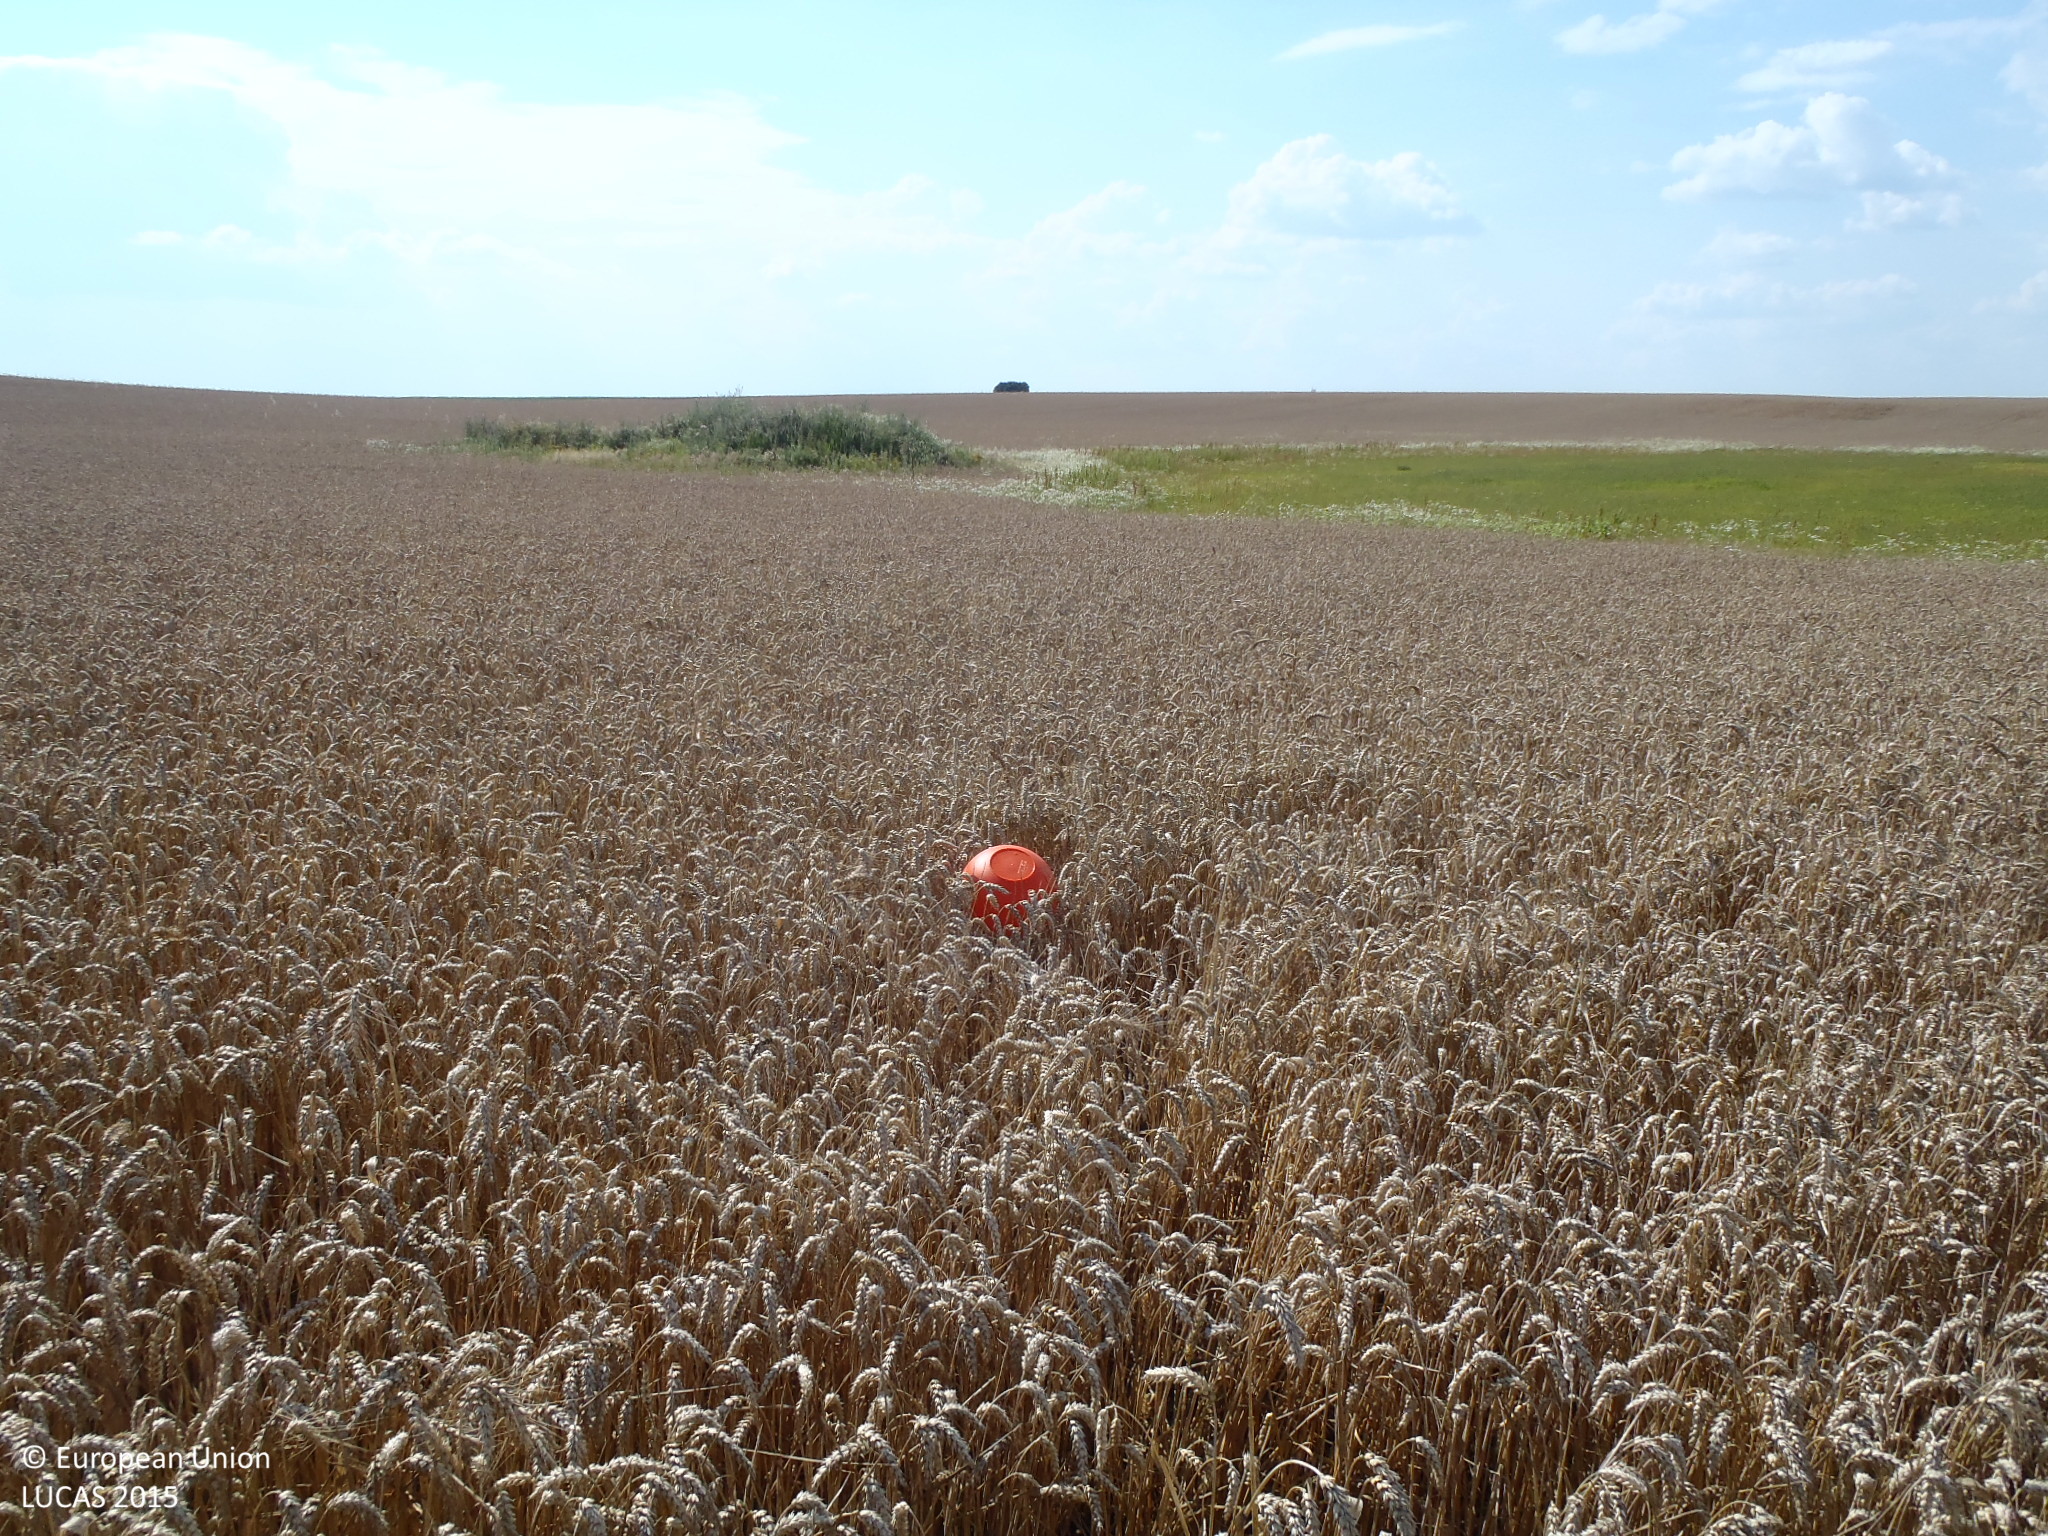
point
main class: Cropland
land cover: Common wheat
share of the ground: > 75 %
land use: Agriculture (excluding fallow land and kitchen gardens)
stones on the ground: < 10 %
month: July
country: BG
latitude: 43.9528
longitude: 26.2915
